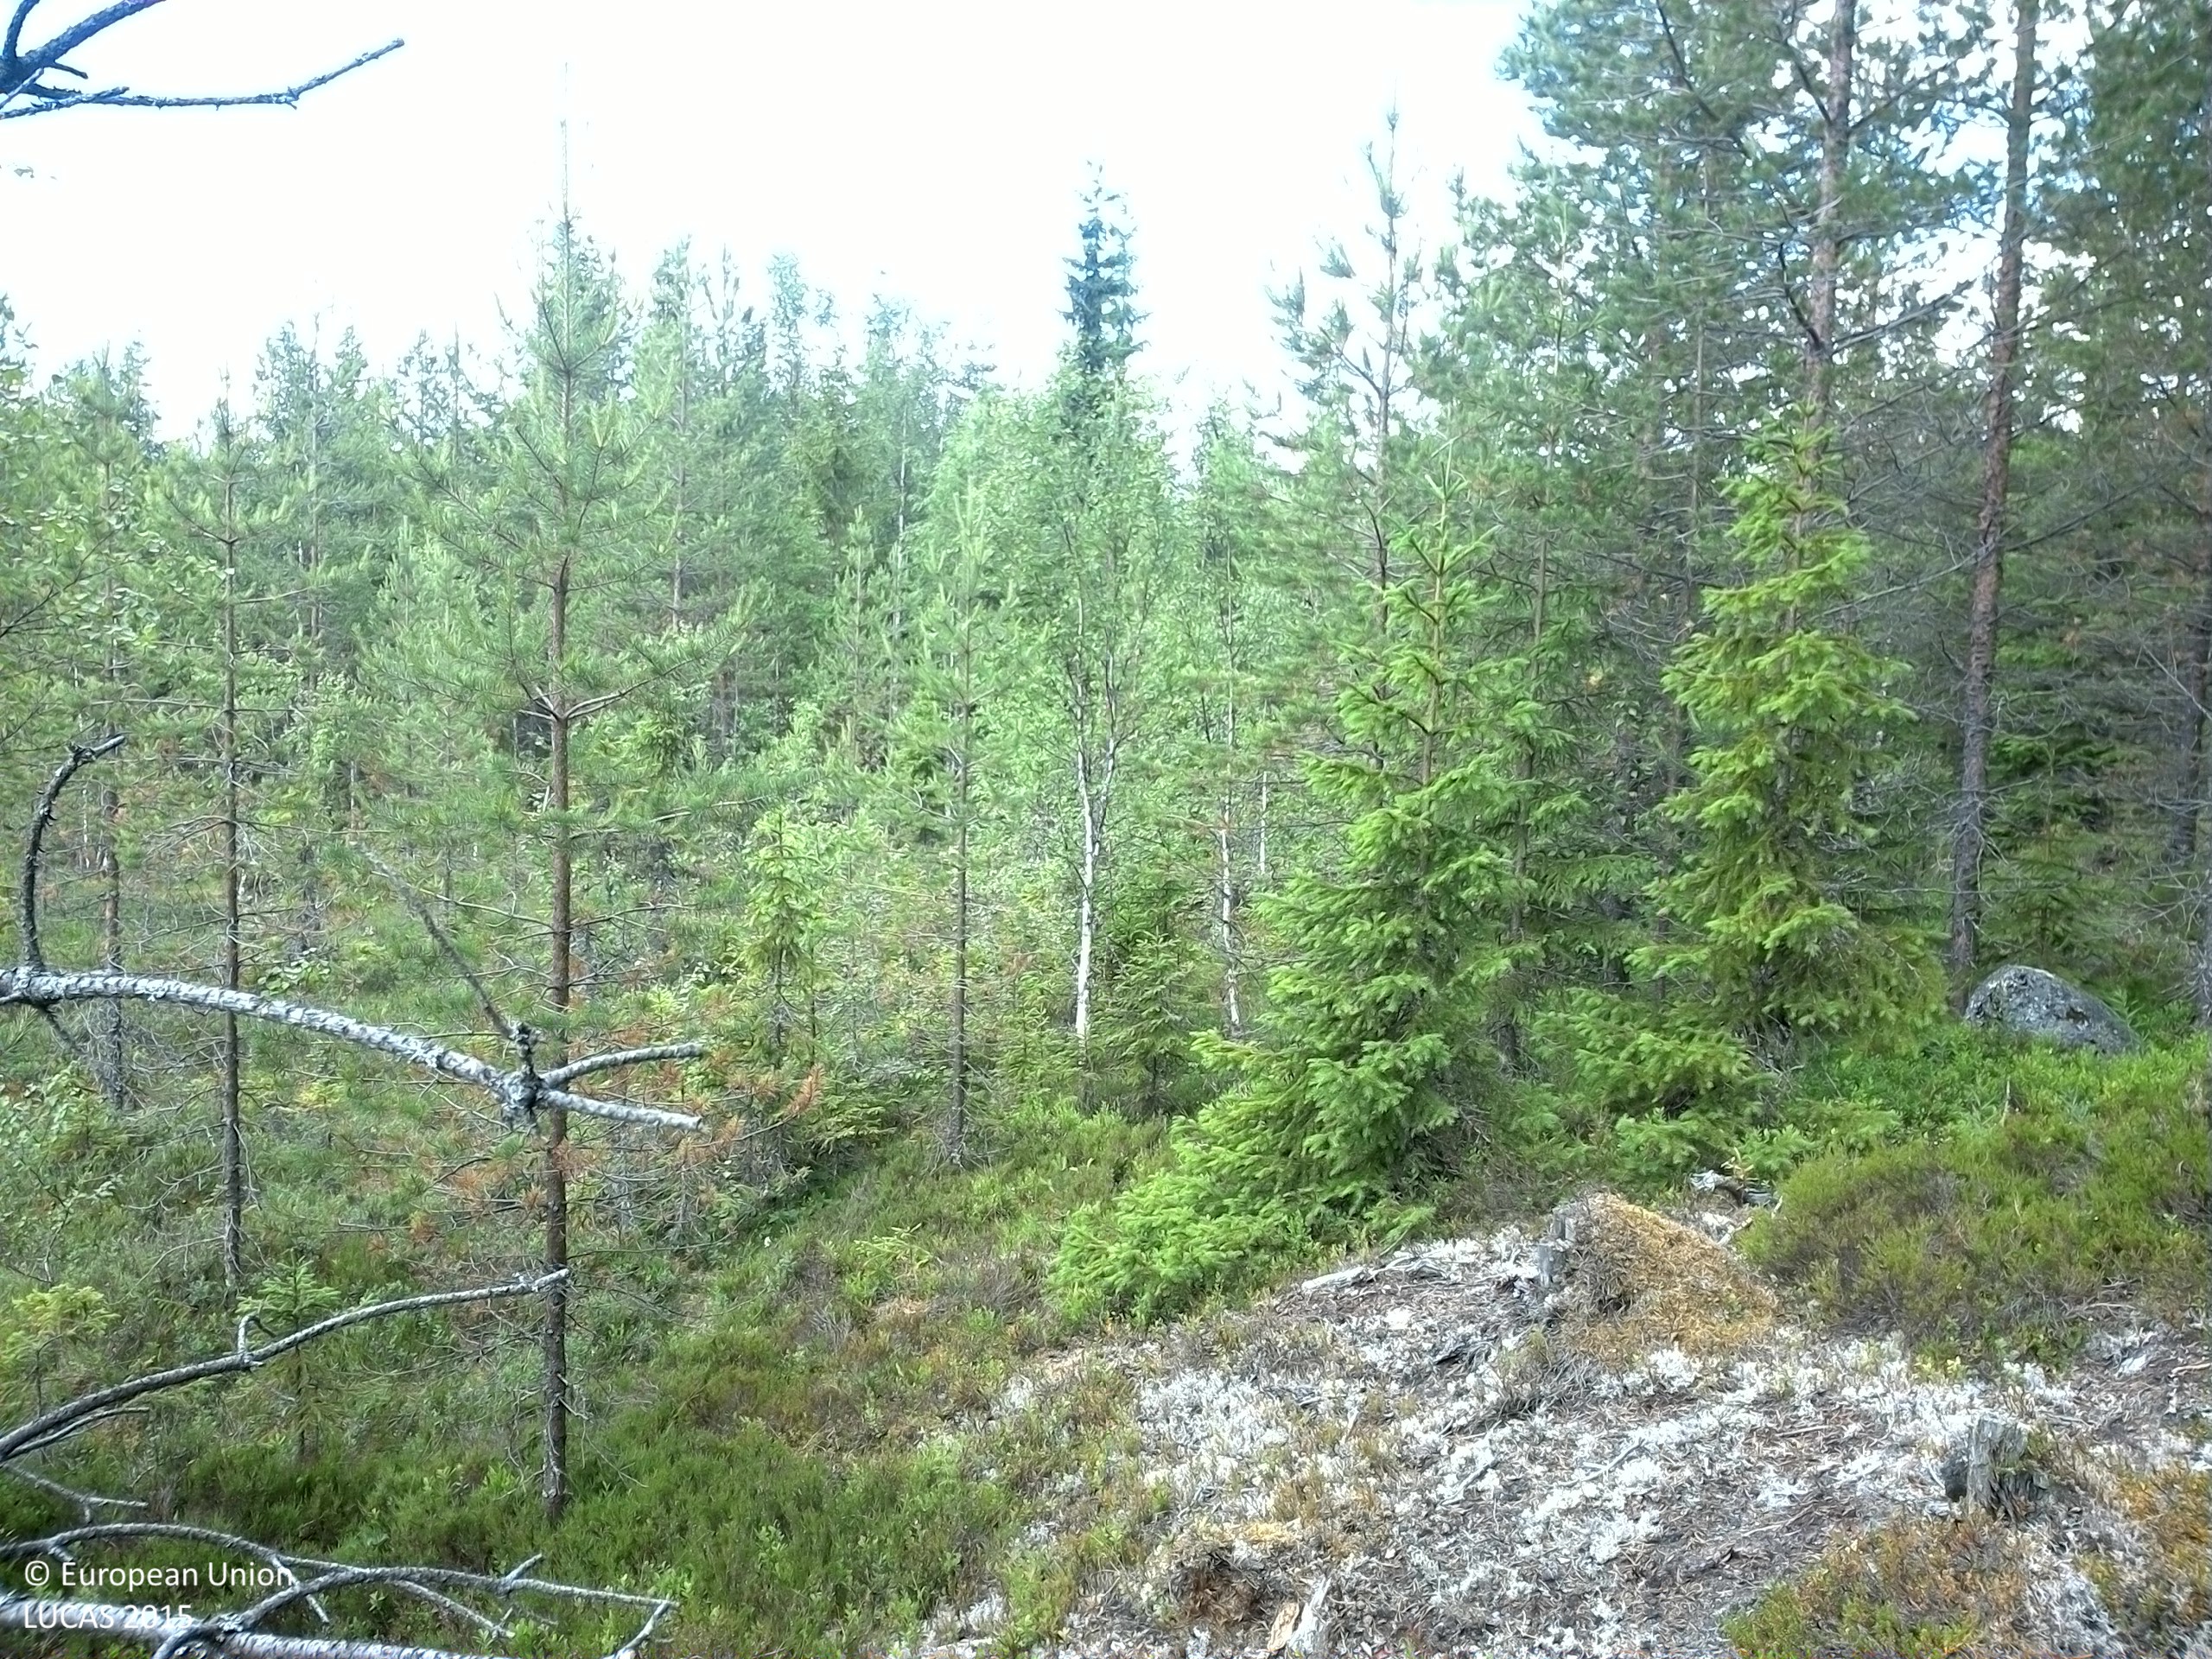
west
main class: Woodland
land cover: Pine dominated coniferous woodland
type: boreal forest
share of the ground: 50 - 75 %
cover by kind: coniferous forest trees 45 %, shrubs 25 %, lichens and mosses 25 %, broadleaved forest trees 5 %
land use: Forestry
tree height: > 5 m
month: July
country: SE
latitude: 63.5466
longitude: 17.5592
